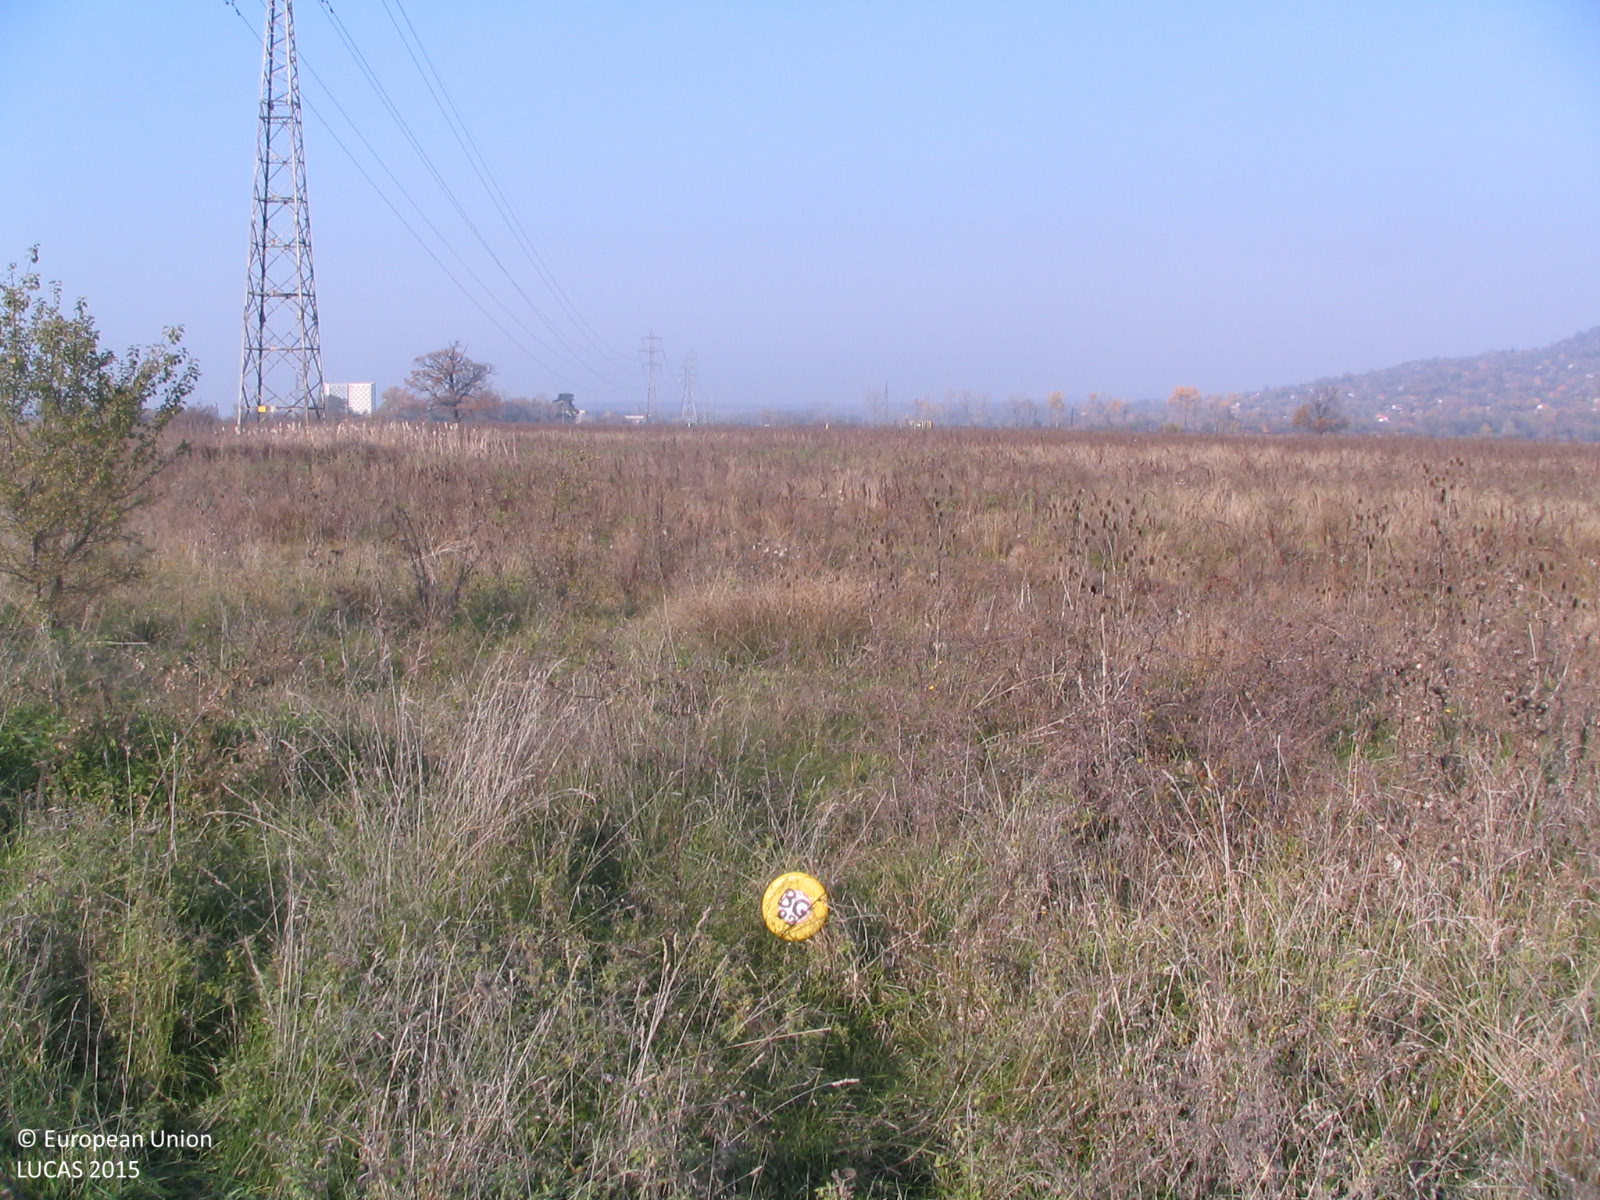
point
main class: Shrubland
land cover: Shrubland without tree cover
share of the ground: 25 - 50 %
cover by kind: herbaceous plants 65 %, shrubs 35 %
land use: Agriculture (excluding fallow land and kitchen gardens)
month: November
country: BG
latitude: 43.2166
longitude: 23.5718
